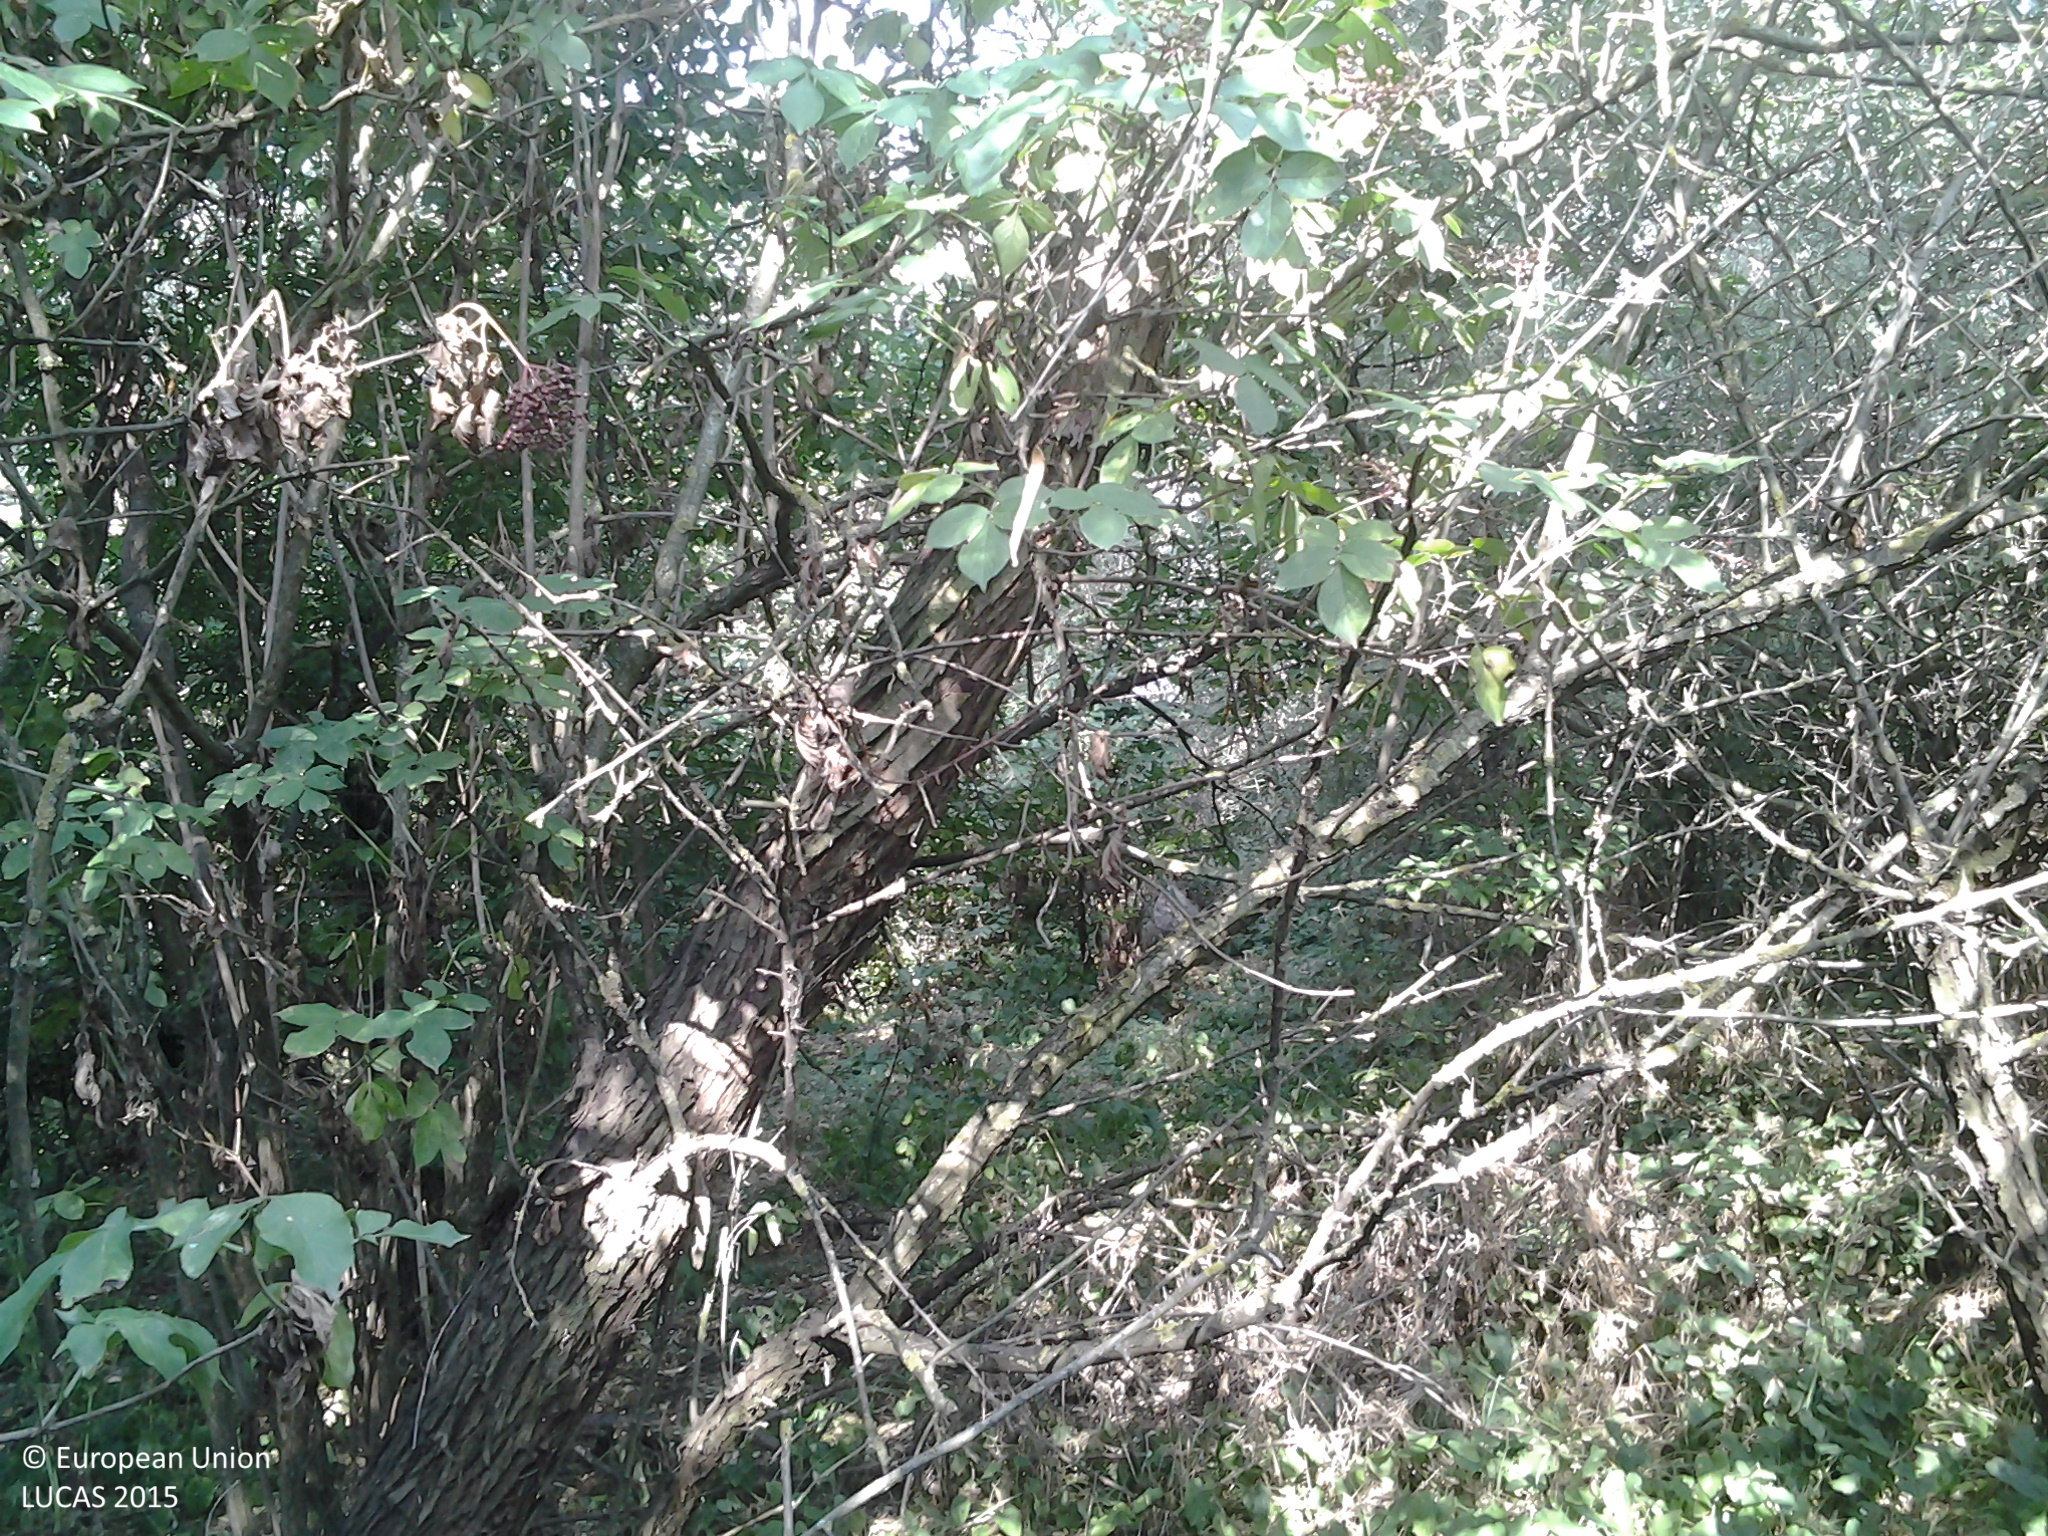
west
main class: Woodland
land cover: Broadleaved woodland
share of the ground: 50 - 75 %
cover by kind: broadleaved forest trees 60 %, herbaceous plants 40 %
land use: Semi-natural and natural areas not in use
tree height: > 5 m
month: July
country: HU
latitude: 46.8032
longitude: 19.2281
